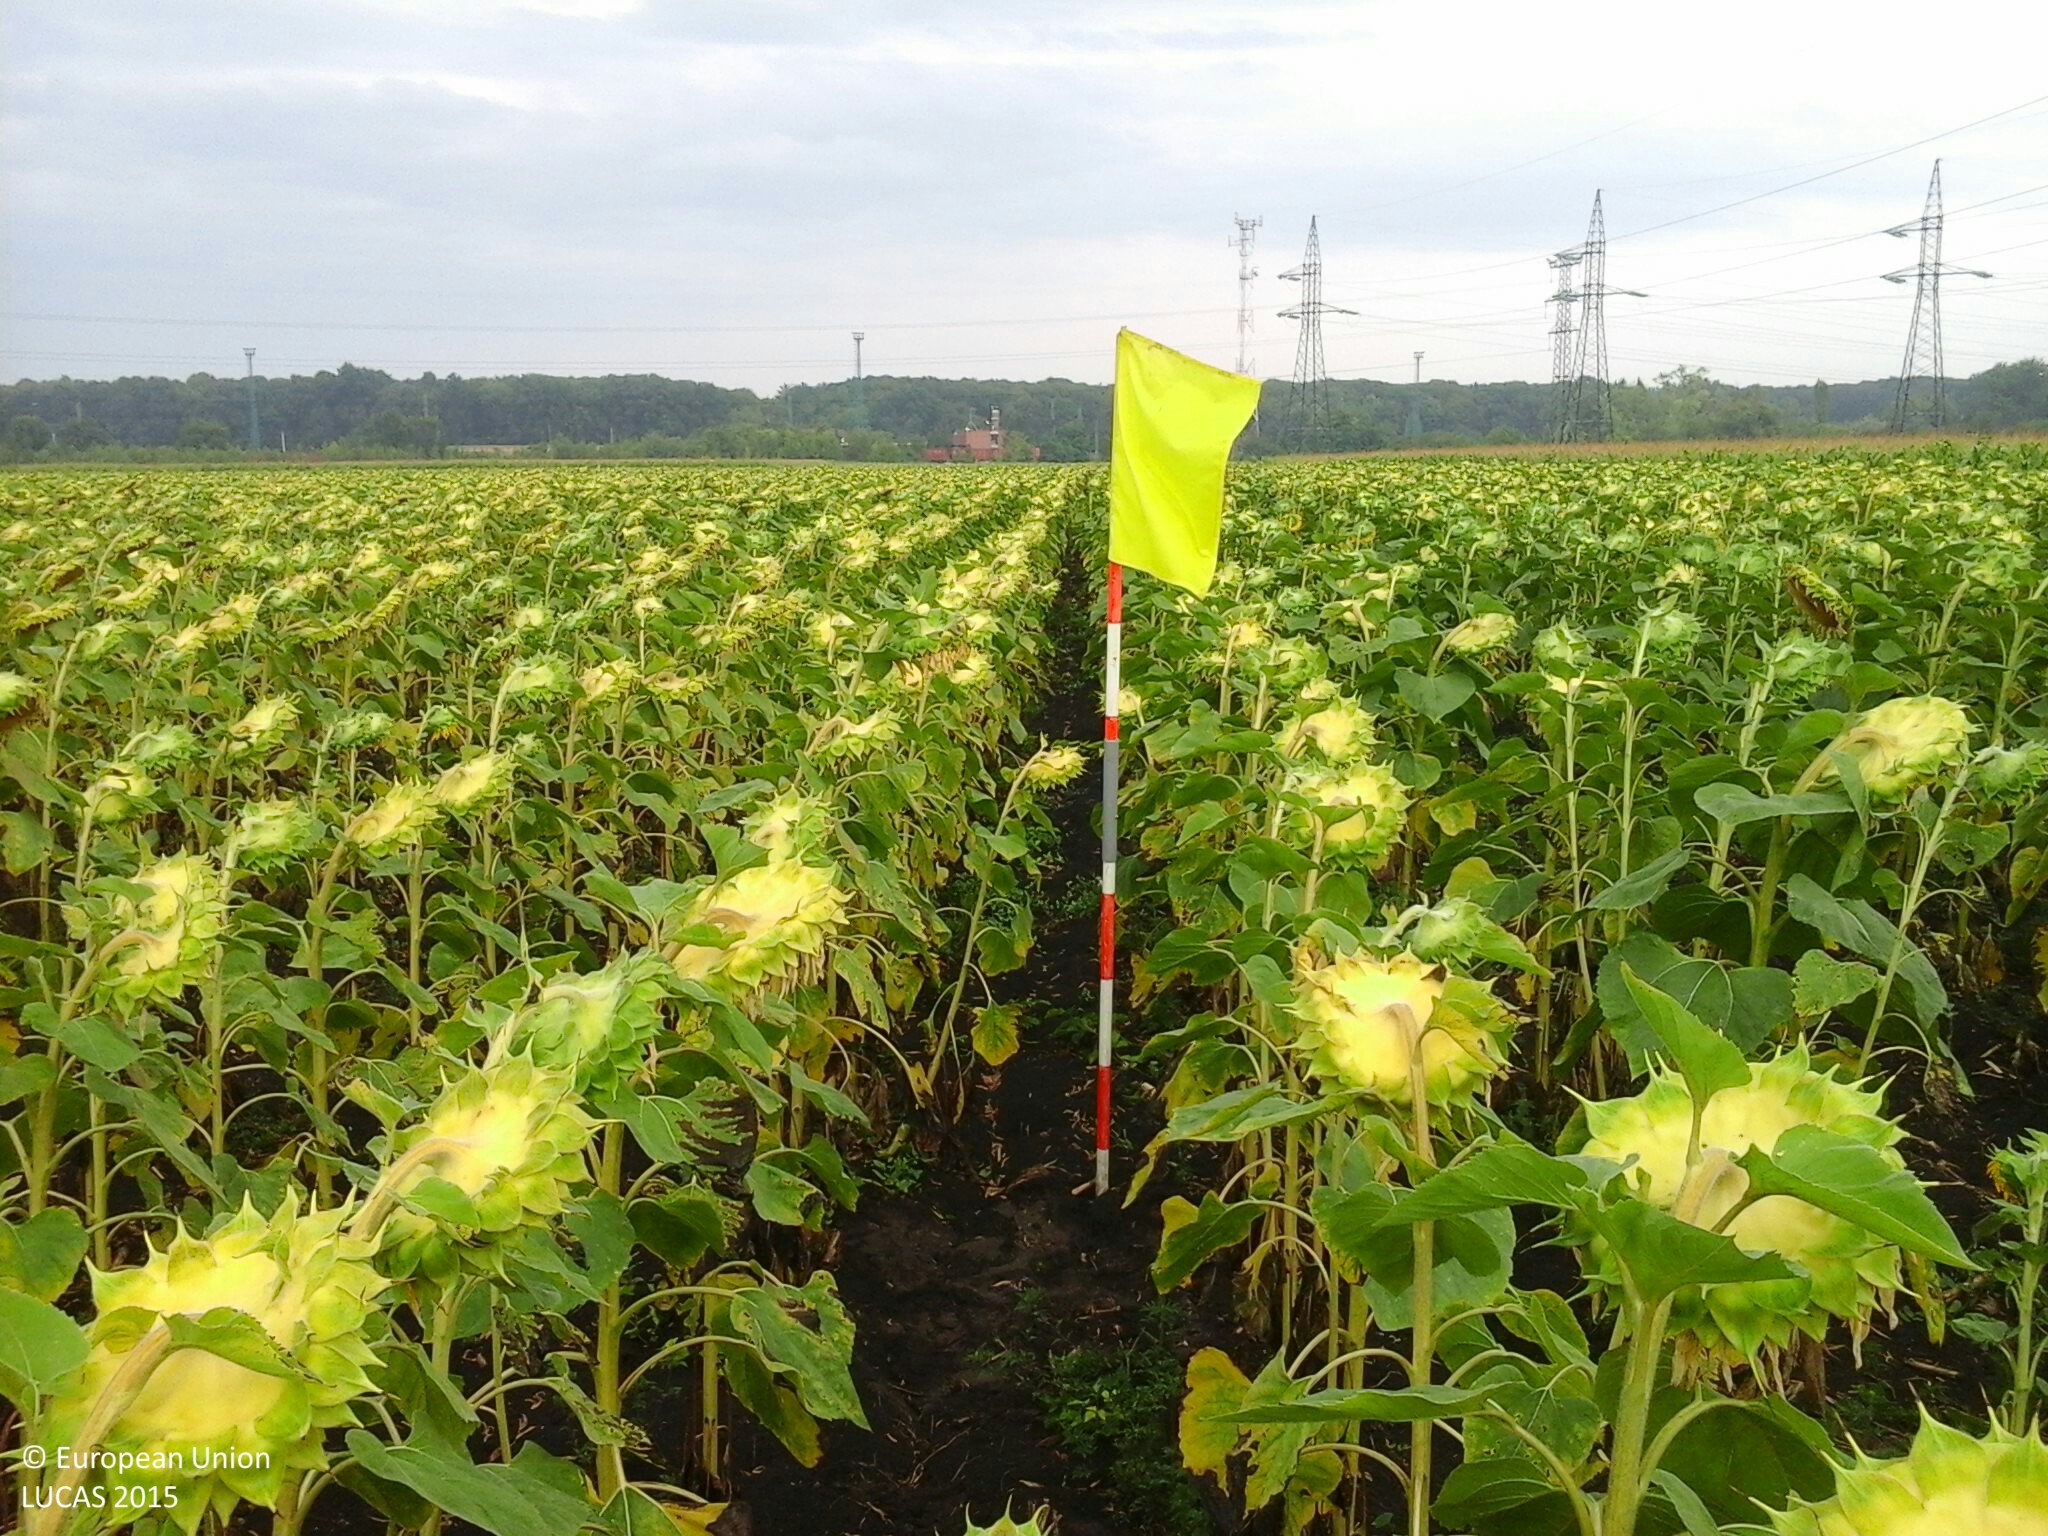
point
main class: Cropland
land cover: Sunflower
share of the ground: > 75 %
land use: Agriculture (excluding fallow land and kitchen gardens)
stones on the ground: < 10 %
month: August
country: HU
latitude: 47.9229
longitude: 21.0260
